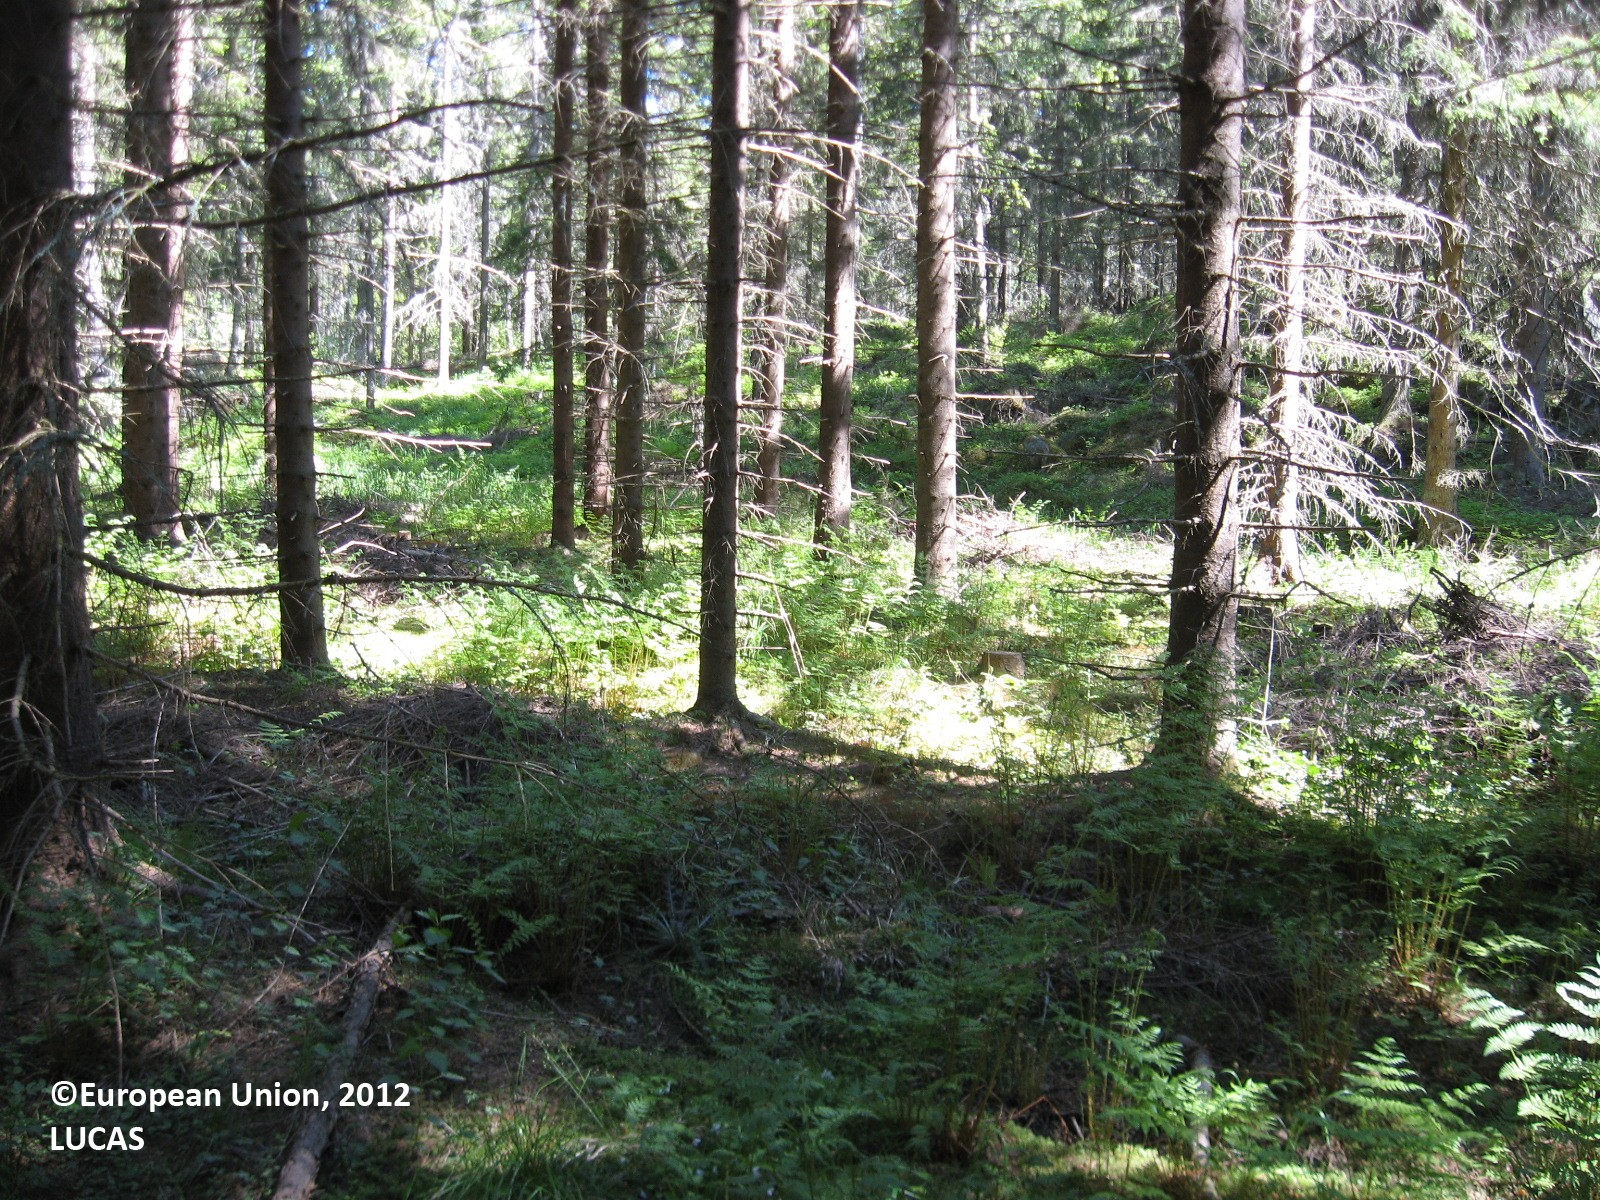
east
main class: Woodland
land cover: Spruce dominated coniferous woodland
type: boreal forest
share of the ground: > 75 %
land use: Forestry
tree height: > 5 m
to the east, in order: Spruce dominated coniferous woodland; Ditches and canals; Paved roads, cycling and walking lanes; Electric lines; Ditches and canals; Spruce dominated coniferous woodland
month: June
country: FI
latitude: 63.2279
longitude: 21.7610
